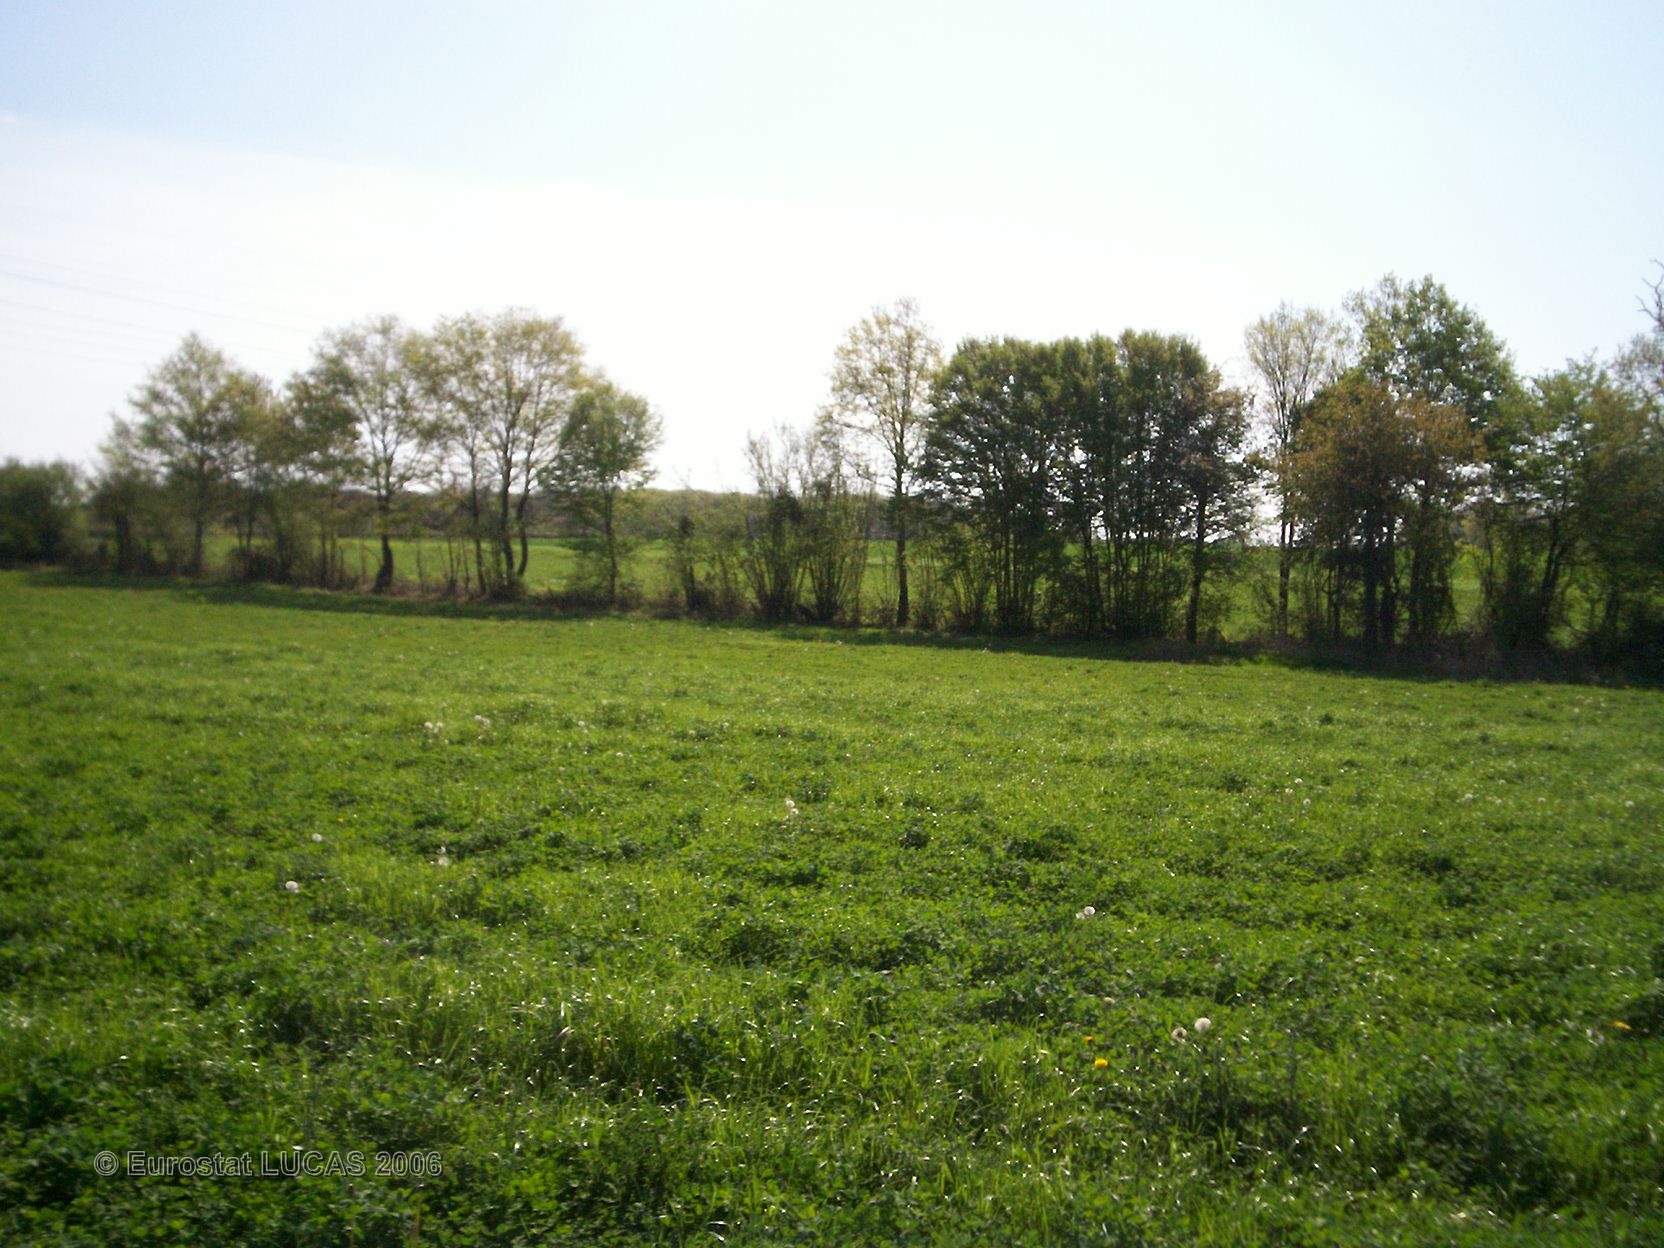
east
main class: Cropland
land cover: Clovers
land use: Agriculture (excluding fallow land and kitchen gardens)
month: May
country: FR
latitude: 46.3490
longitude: 1.6357
